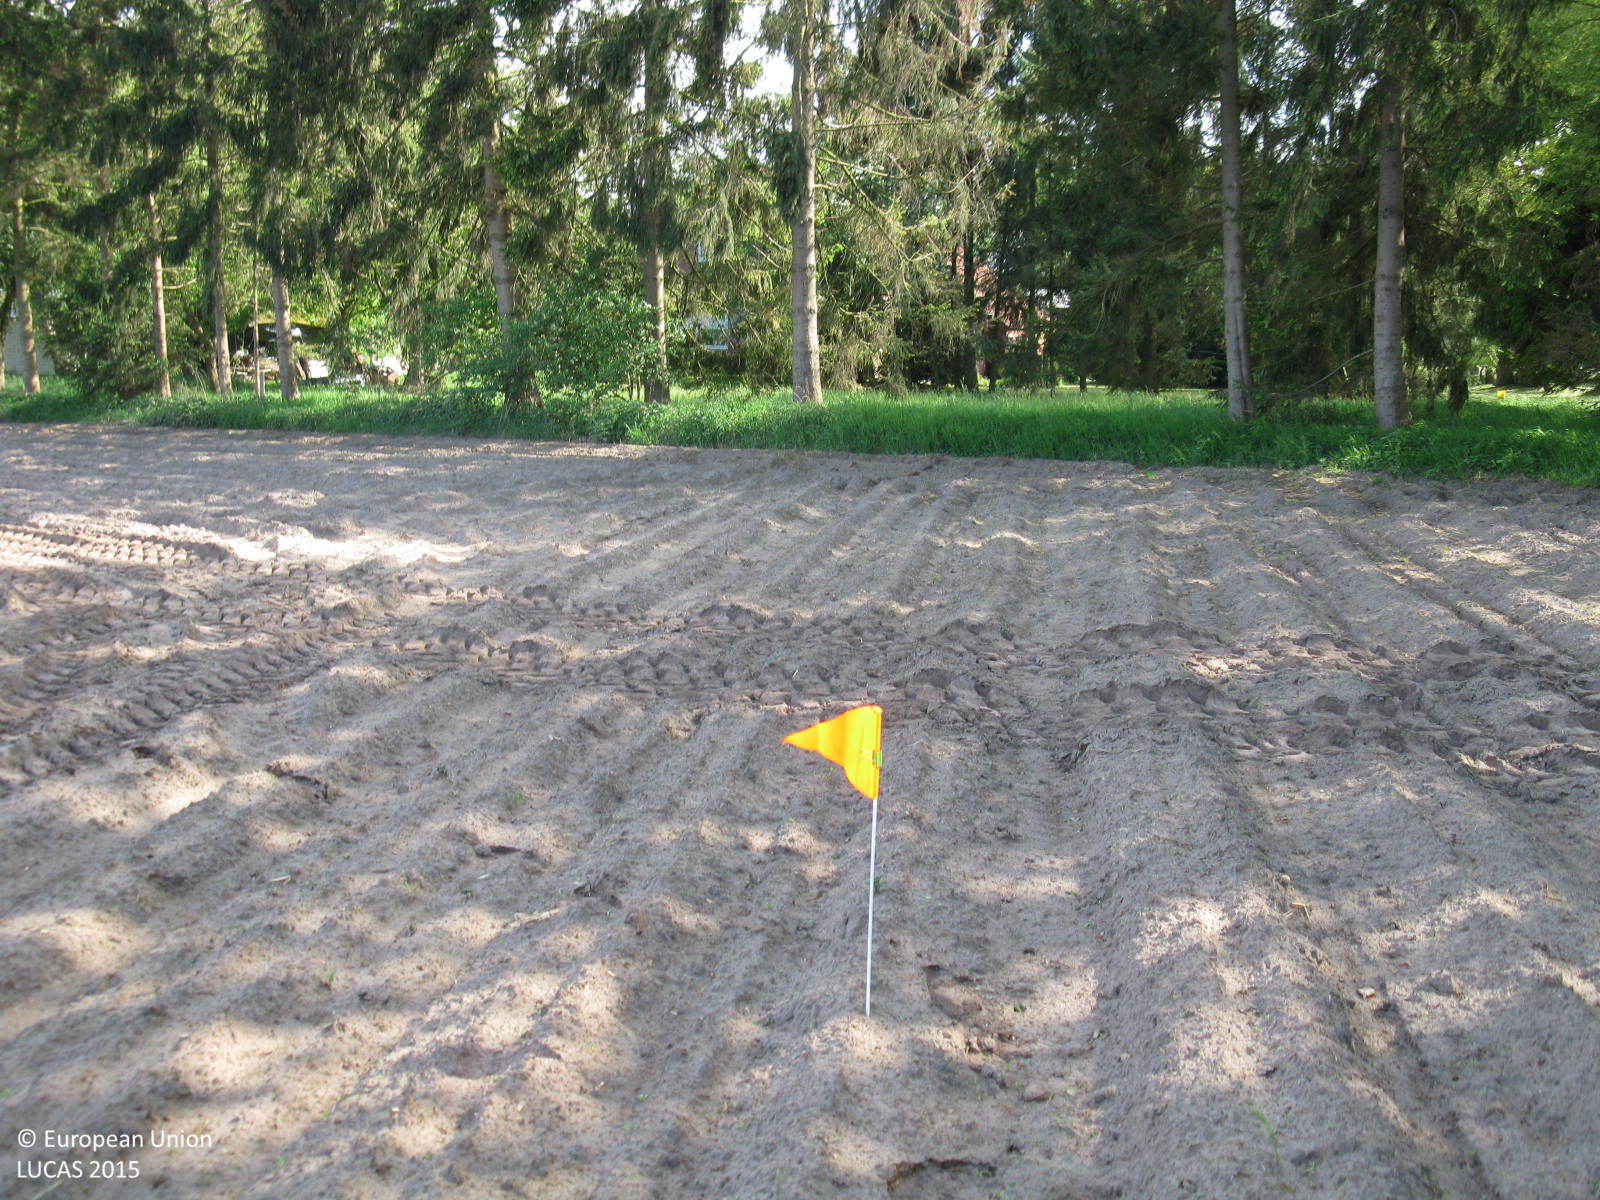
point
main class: Cropland
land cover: Potatoes
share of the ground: < 10 %
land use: Agriculture (excluding fallow land and kitchen gardens)
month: May
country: DE
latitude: 53.0136
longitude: 7.3623
